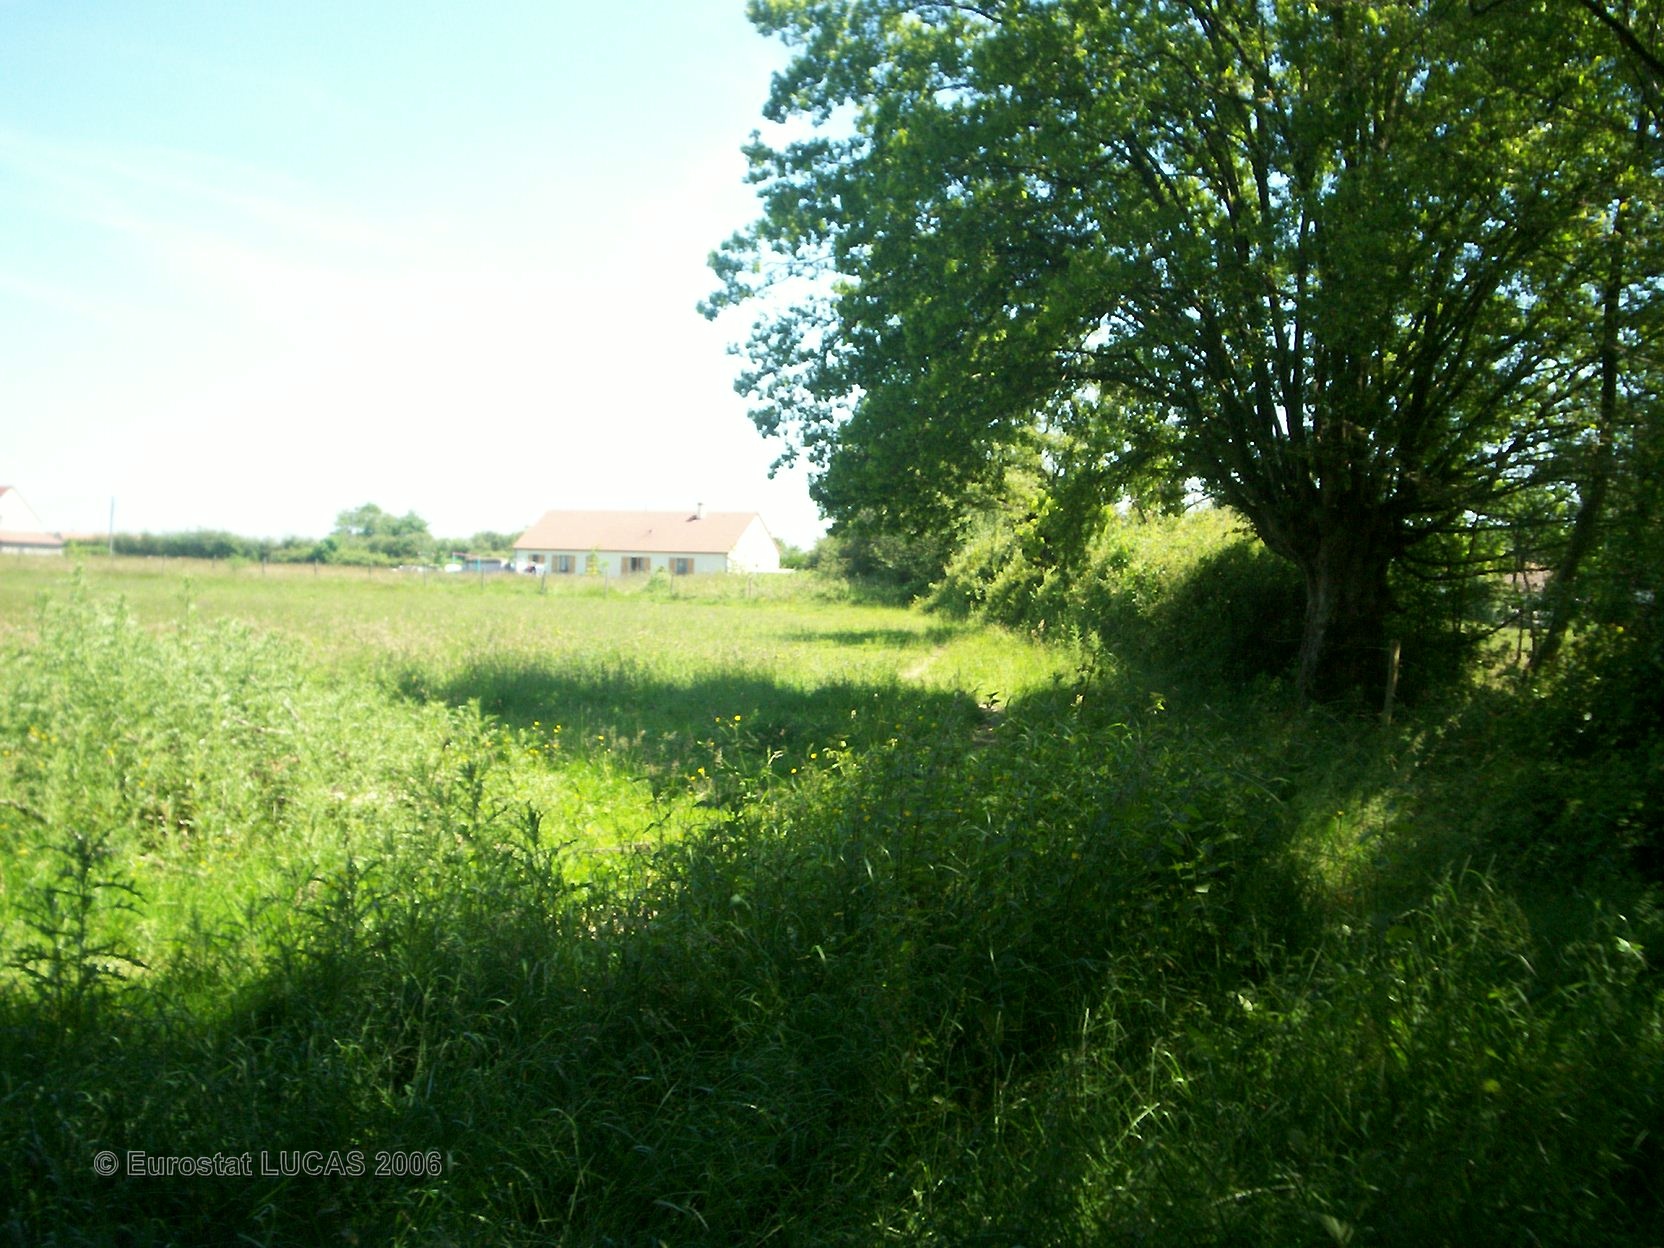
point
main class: Grassland
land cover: Grassland with sparse tree/shrub cover
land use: Agriculture (excluding fallow land and kitchen gardens)
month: June
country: FR
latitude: 46.9560
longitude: 3.0447
